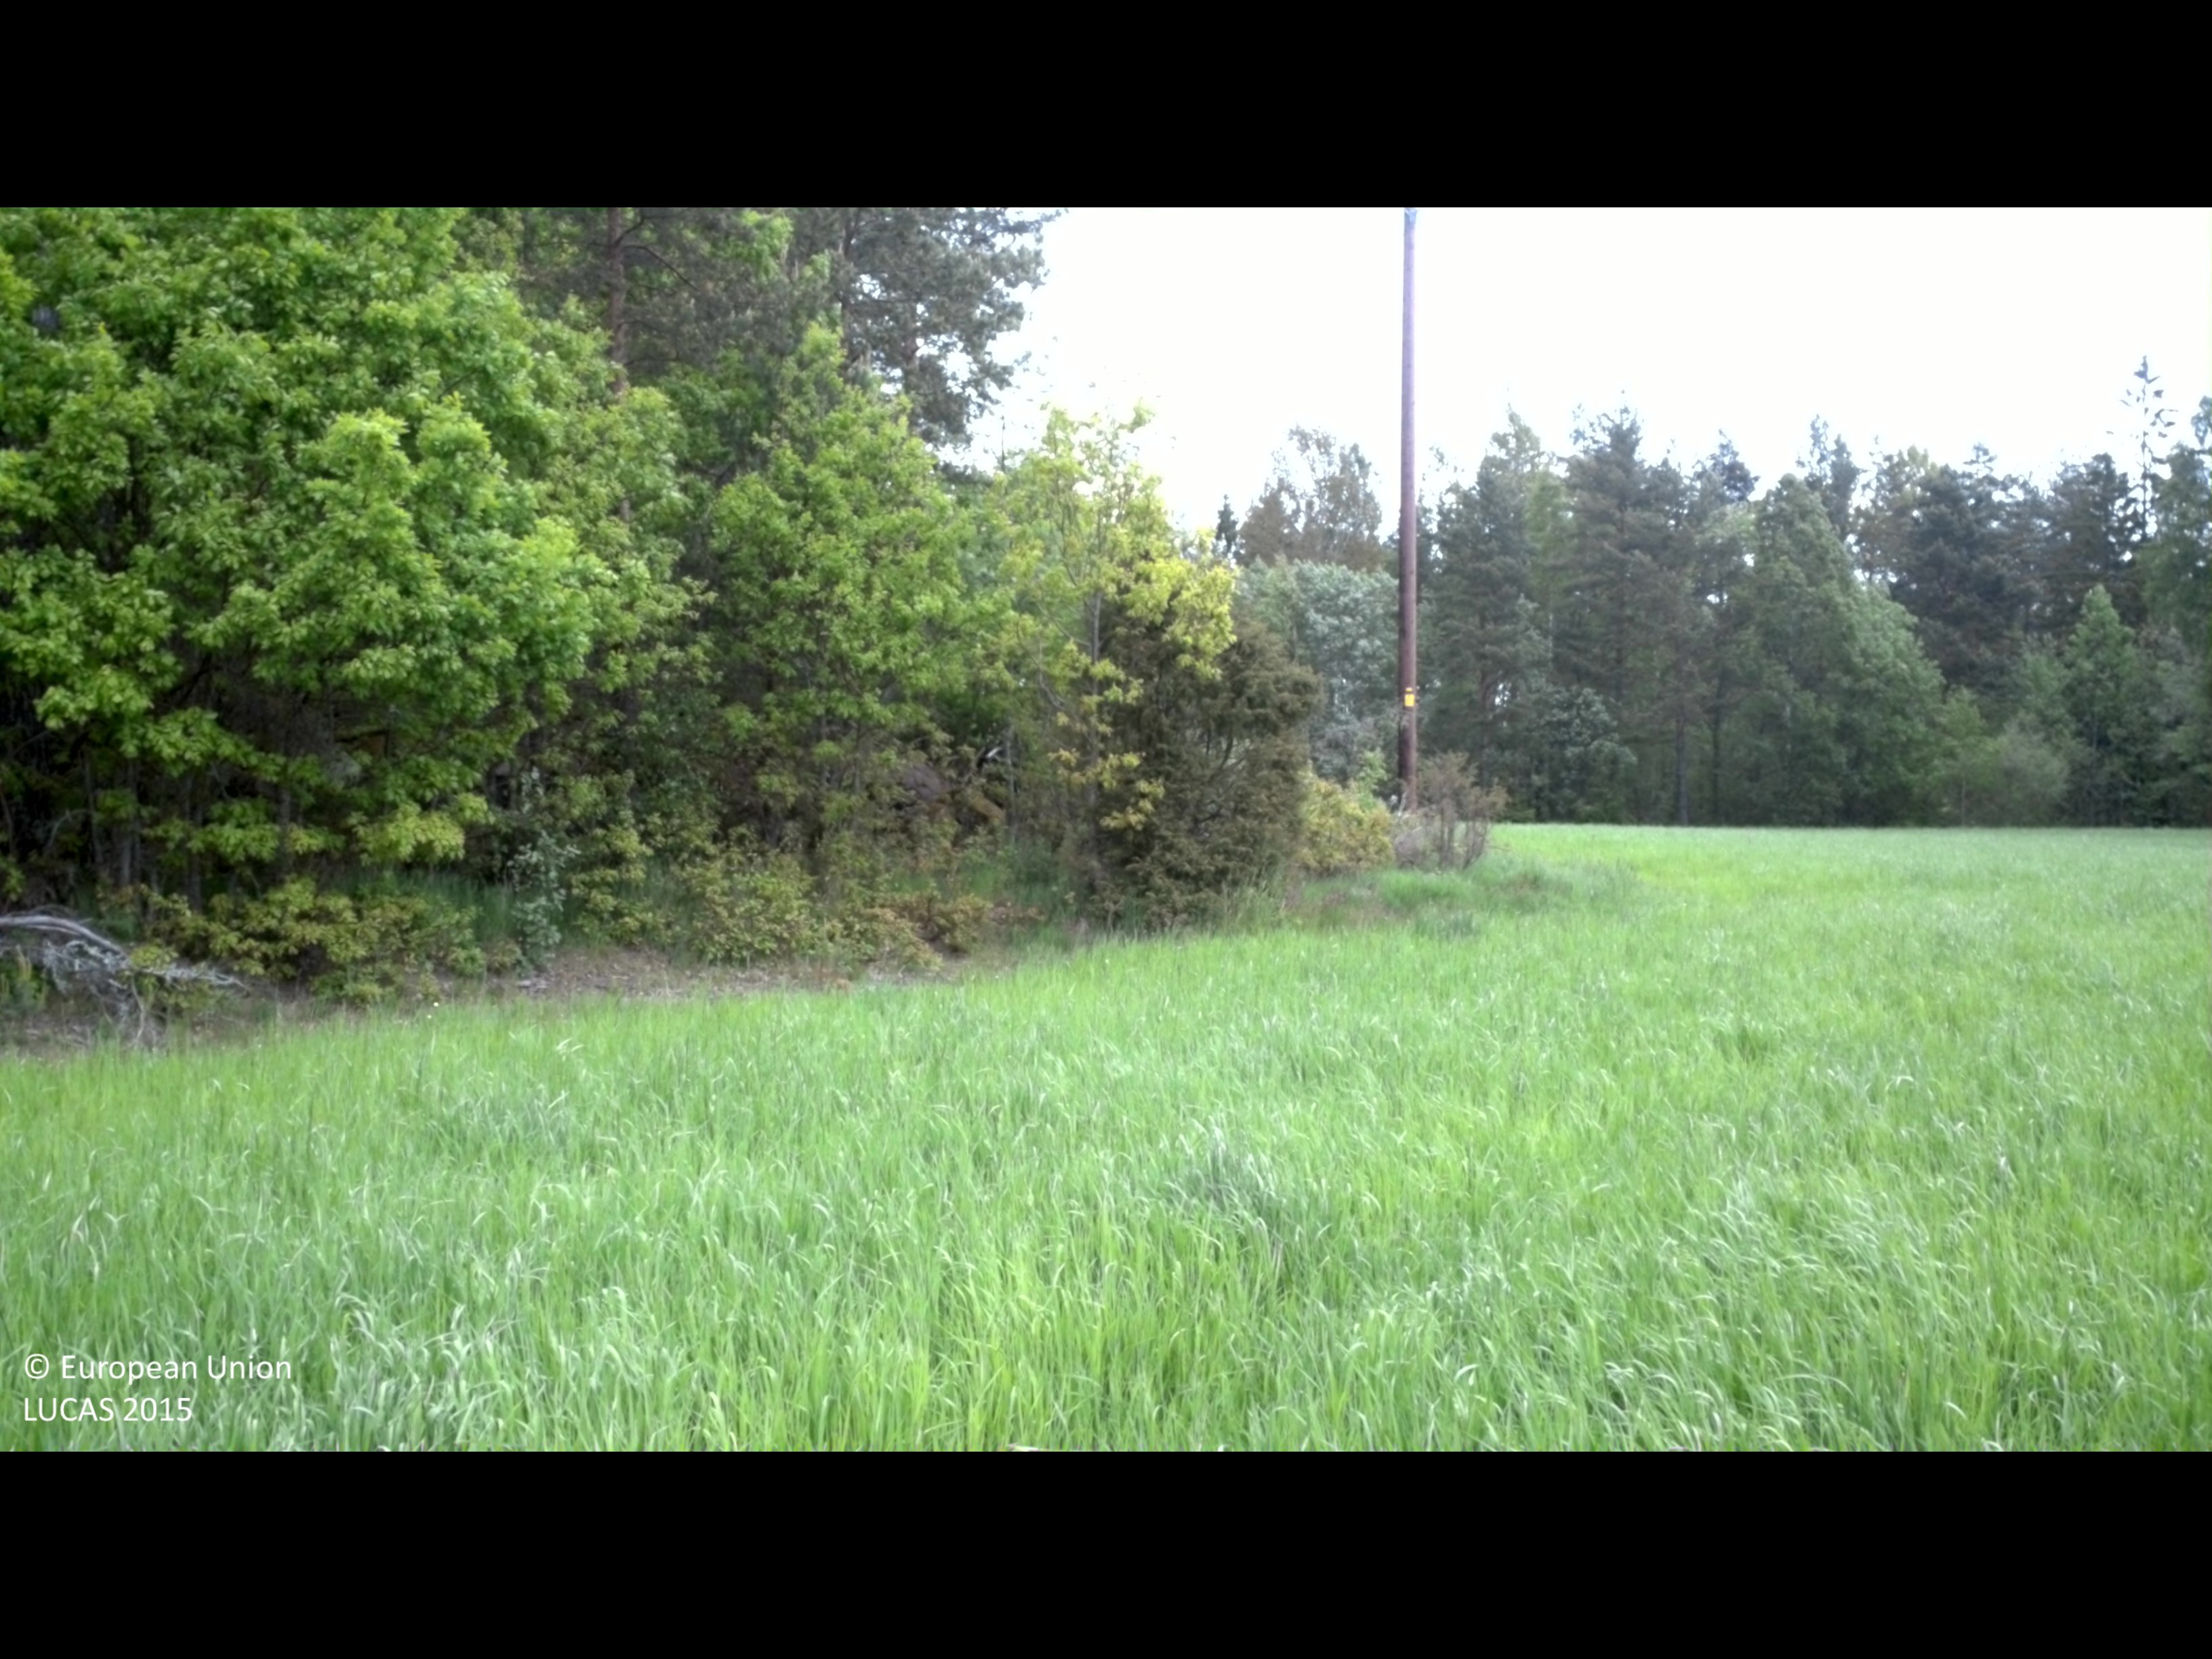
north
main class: Grassland
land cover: Grassland without tree/shrub cover
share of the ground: > 75 %
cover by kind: herbaceous plants 100 %
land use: Agriculture (excluding fallow land and kitchen gardens)
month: May
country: SE
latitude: 57.4429
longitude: 16.6142
